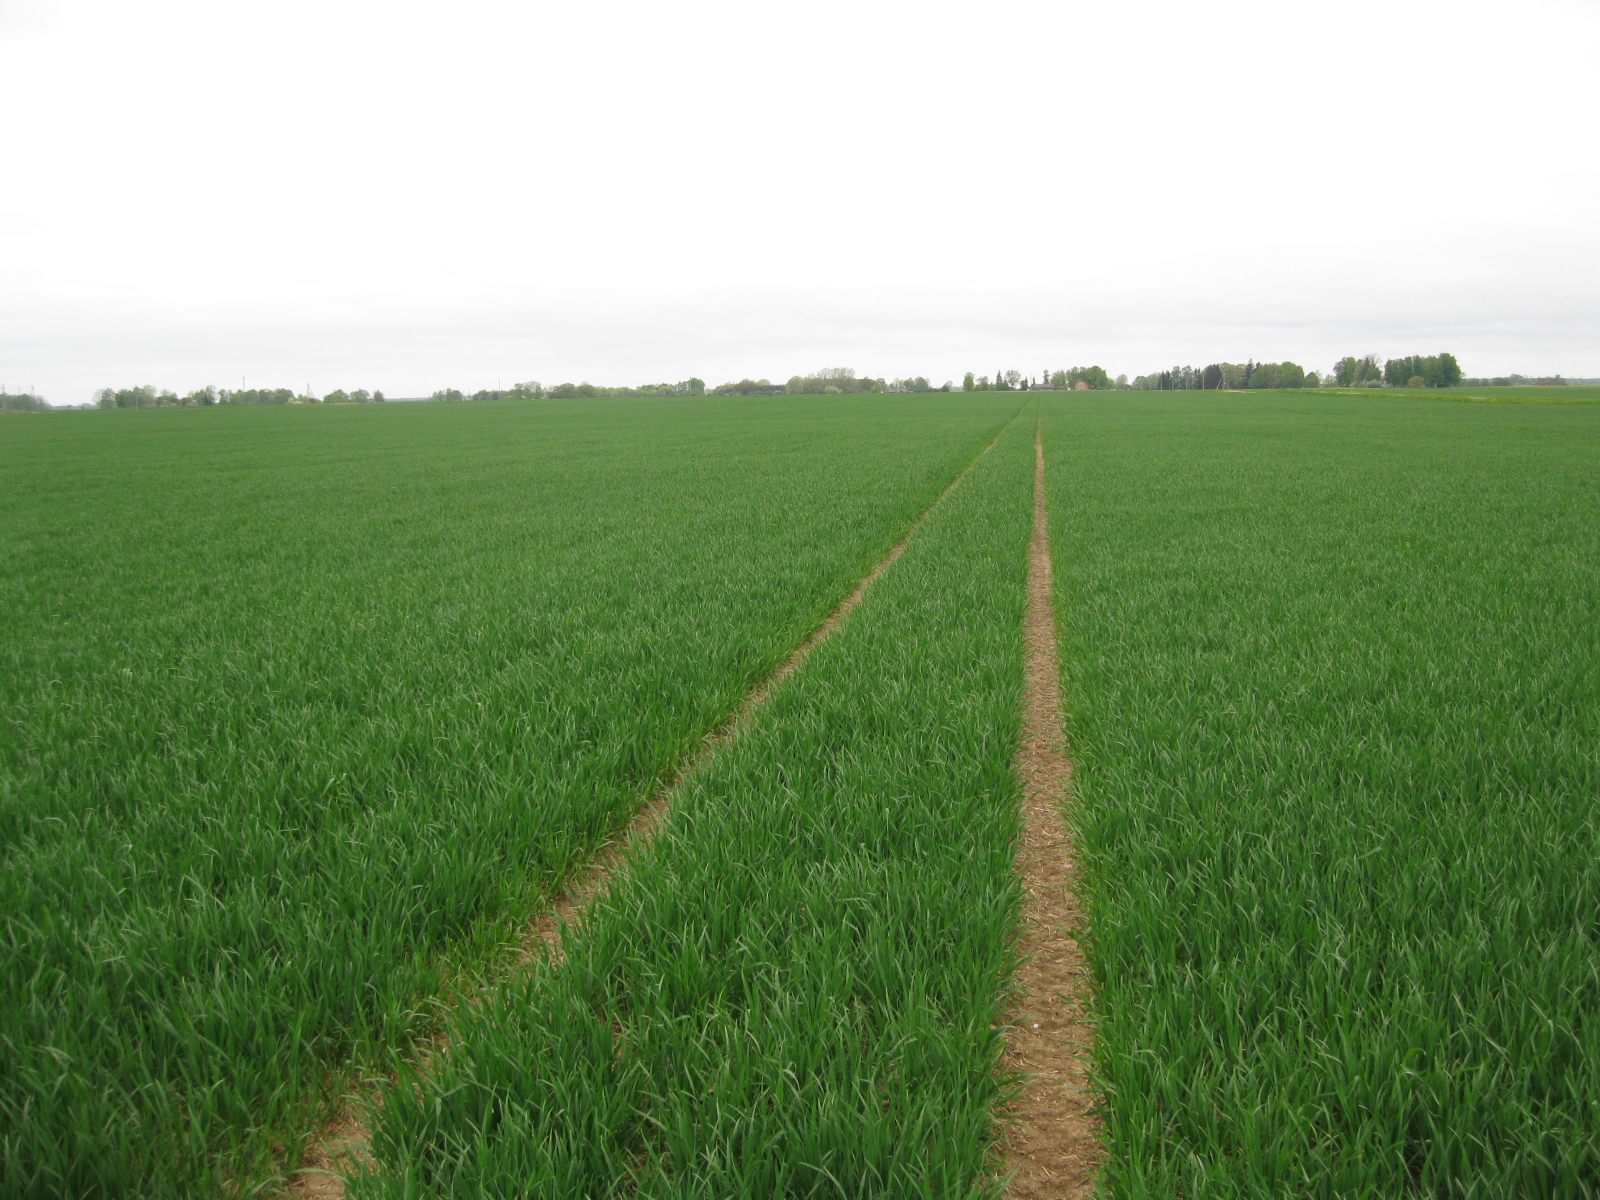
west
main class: Cropland
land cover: Common wheat
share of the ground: > 75 %
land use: Agriculture (excluding fallow land and kitchen gardens)
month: May
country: LT
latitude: 55.9939
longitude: 24.3802
